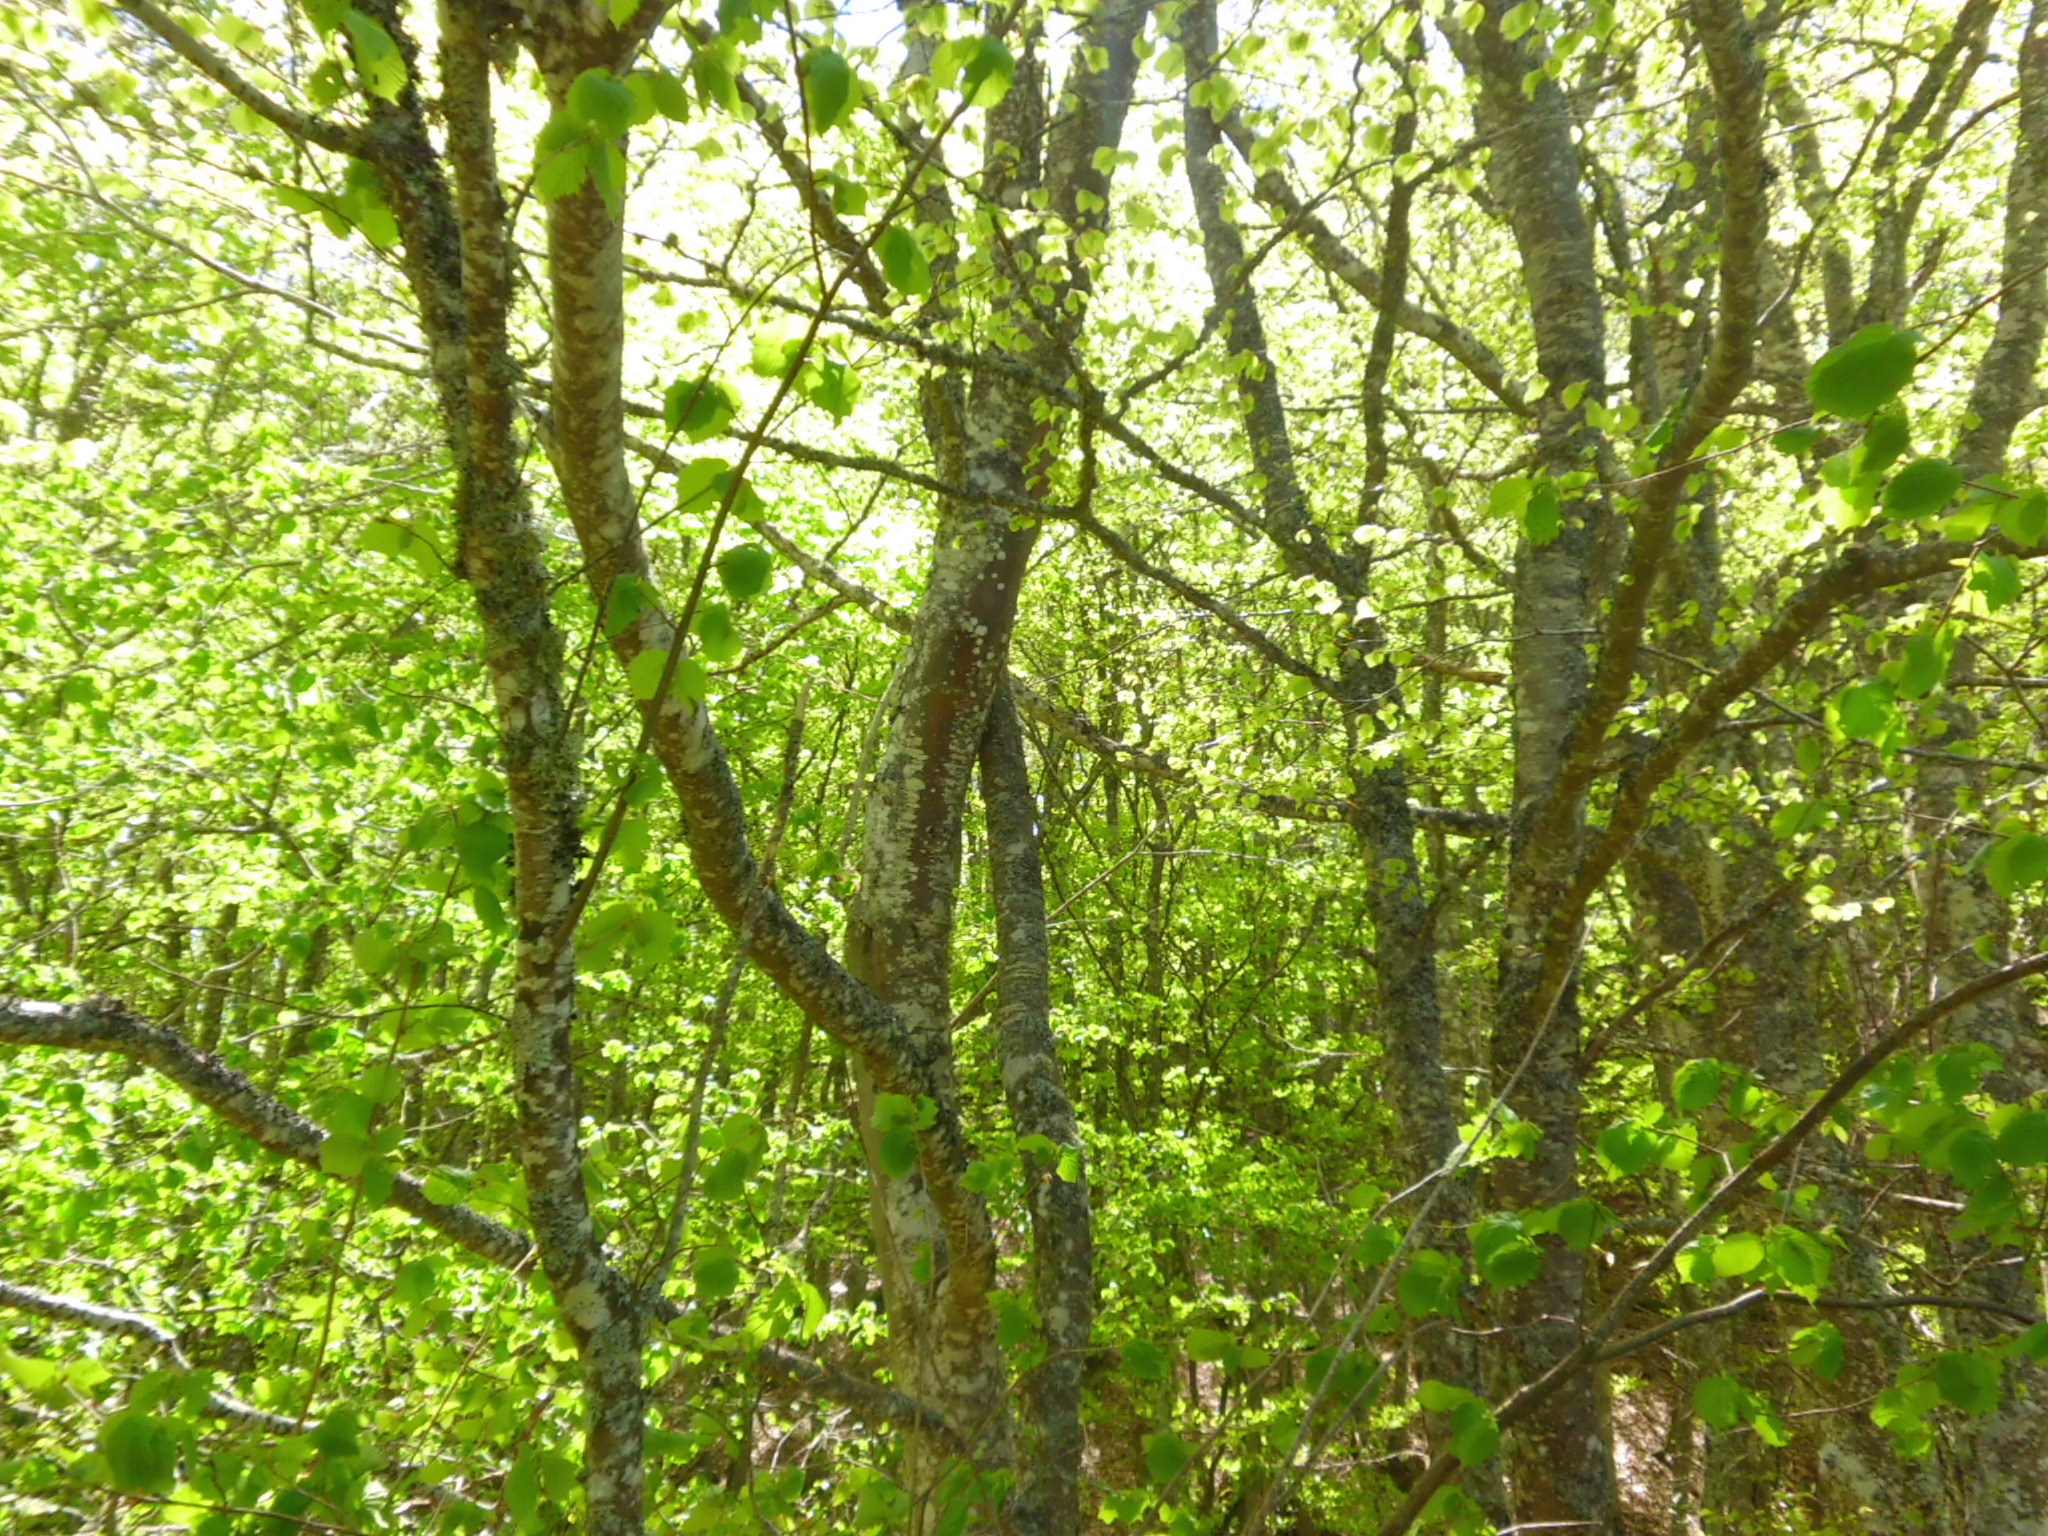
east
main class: Woodland
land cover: Broadleaved woodland
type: acidophilous oak and oak-birch forest
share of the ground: 50 - 75 %
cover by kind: broadleaved forest trees 70 %, shrubs 20 %, herbaceous plants 10 %
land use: Semi-natural and natural areas not in use
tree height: > 5 m
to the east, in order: Broadleaved woodland; Grassland with sparse tree/shrub cover
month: May
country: ES
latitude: 42.9027
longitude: -3.9966
